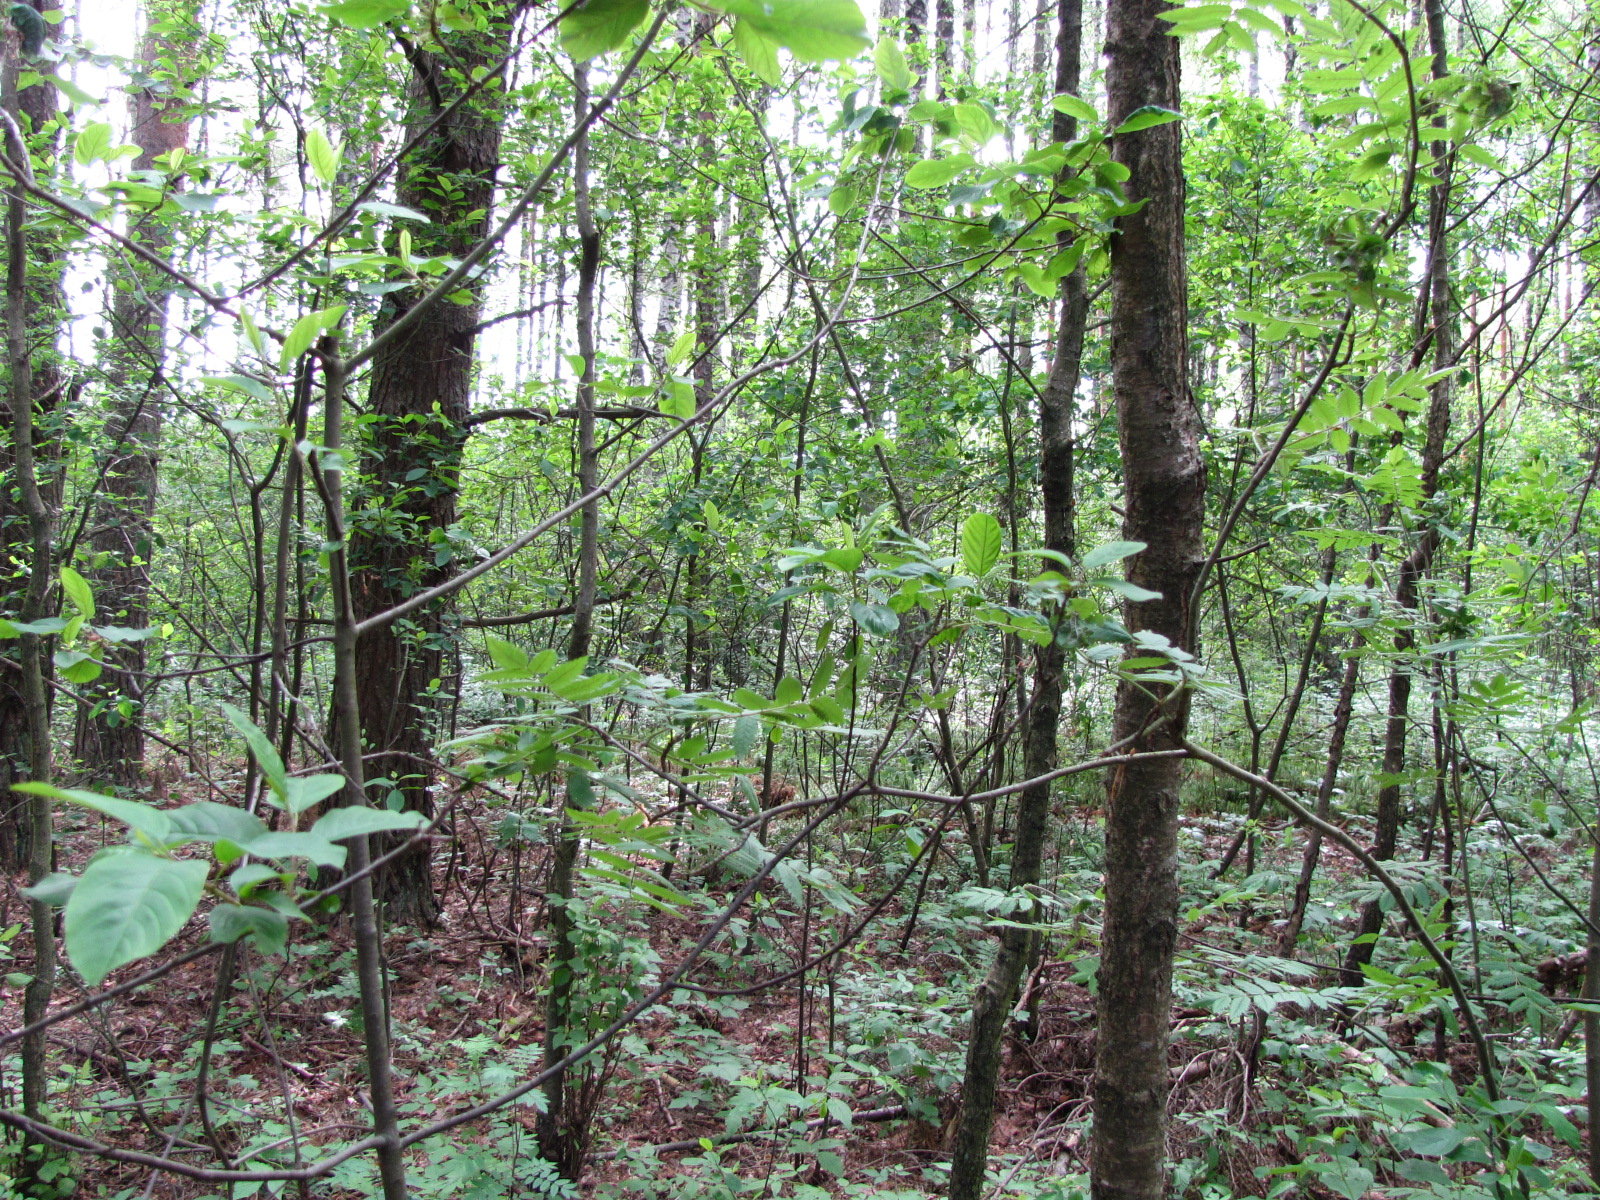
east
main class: Woodland
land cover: Pine dominated mixed woodland
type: mire and swamp forests
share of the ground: > 75 %
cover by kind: coniferous forest trees 70 %, broadleaved forest trees 30 %
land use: Forestry
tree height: > 5 m
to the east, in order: Pine dominated mixed woodland; Broadleaved woodland; Ditches and canals; Broadleaved woodland; Grassland without tree/shrub cover
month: June
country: LV
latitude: 56.8726
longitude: 23.8789
